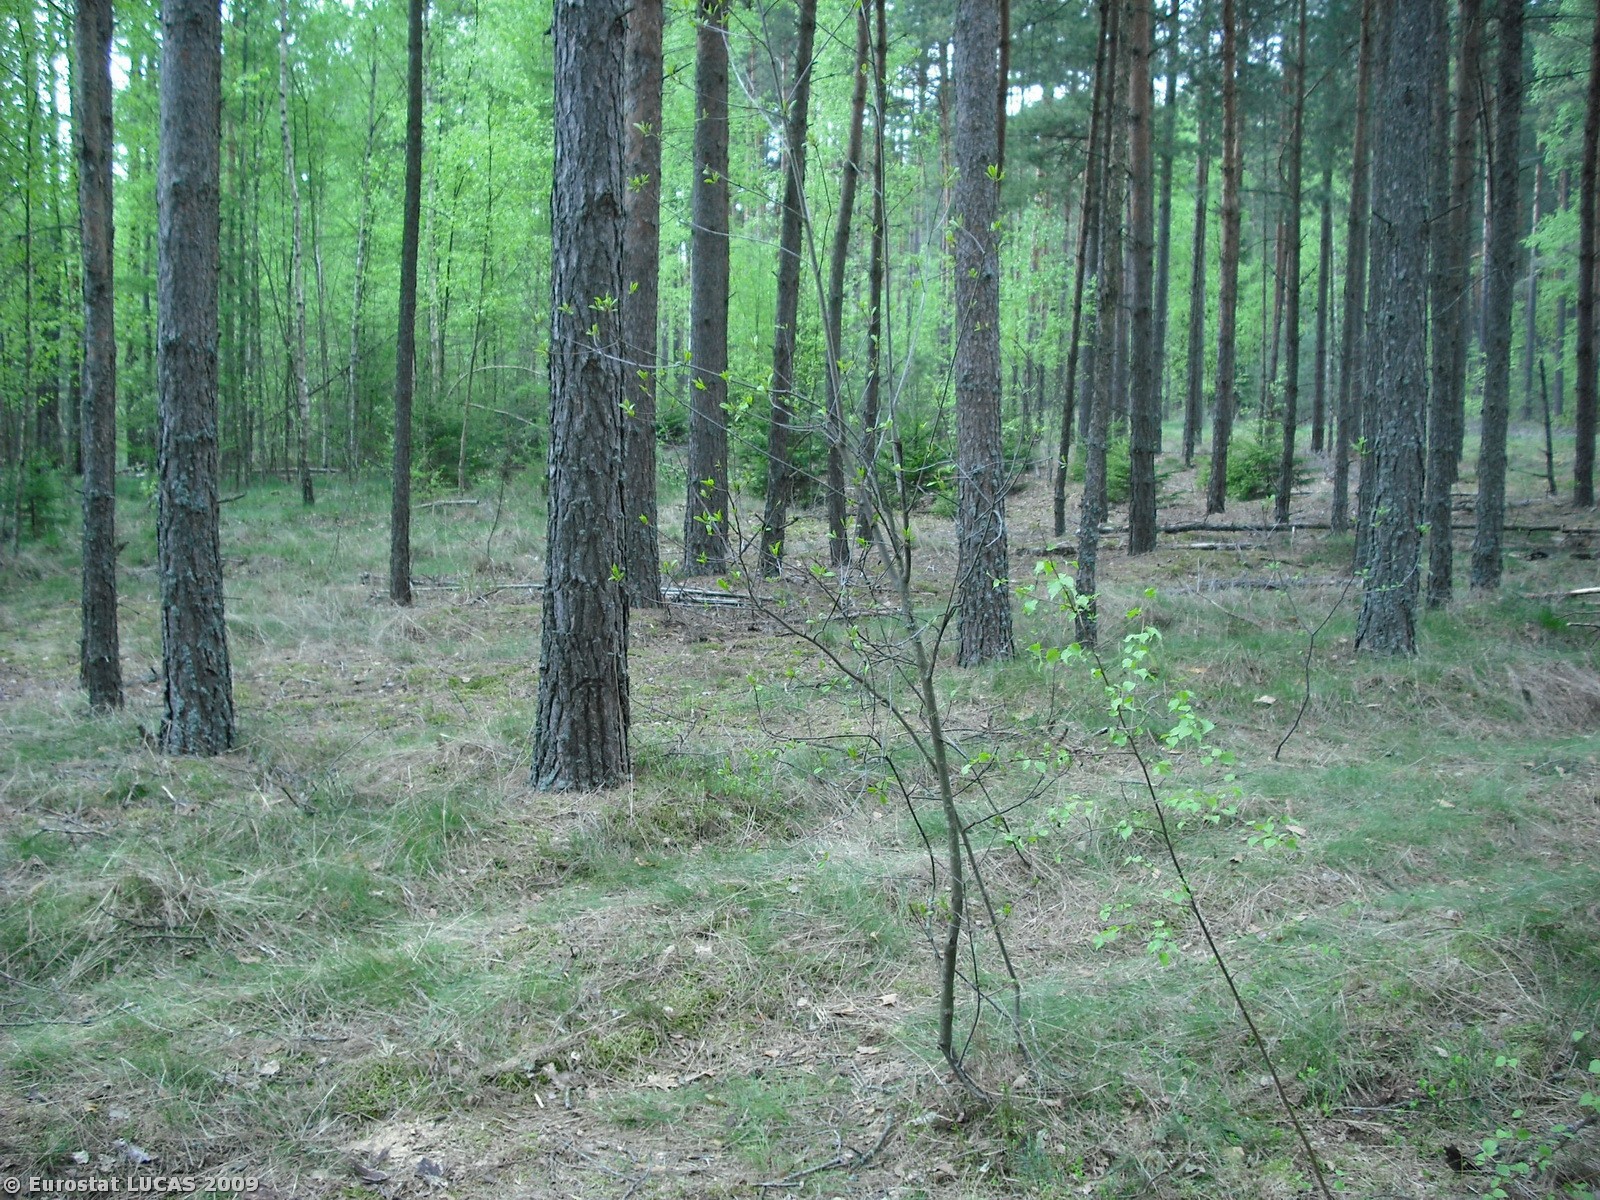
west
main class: Woodland
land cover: Mixed woodland
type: hemiboreal forest and nemoral coniferous forest and mixed broadleaved-coniferous forest
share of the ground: 50 - 75 %
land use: Forestry
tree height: > 5 m
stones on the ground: < 10 %
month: August
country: PL
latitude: 53.1039
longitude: 23.6036
